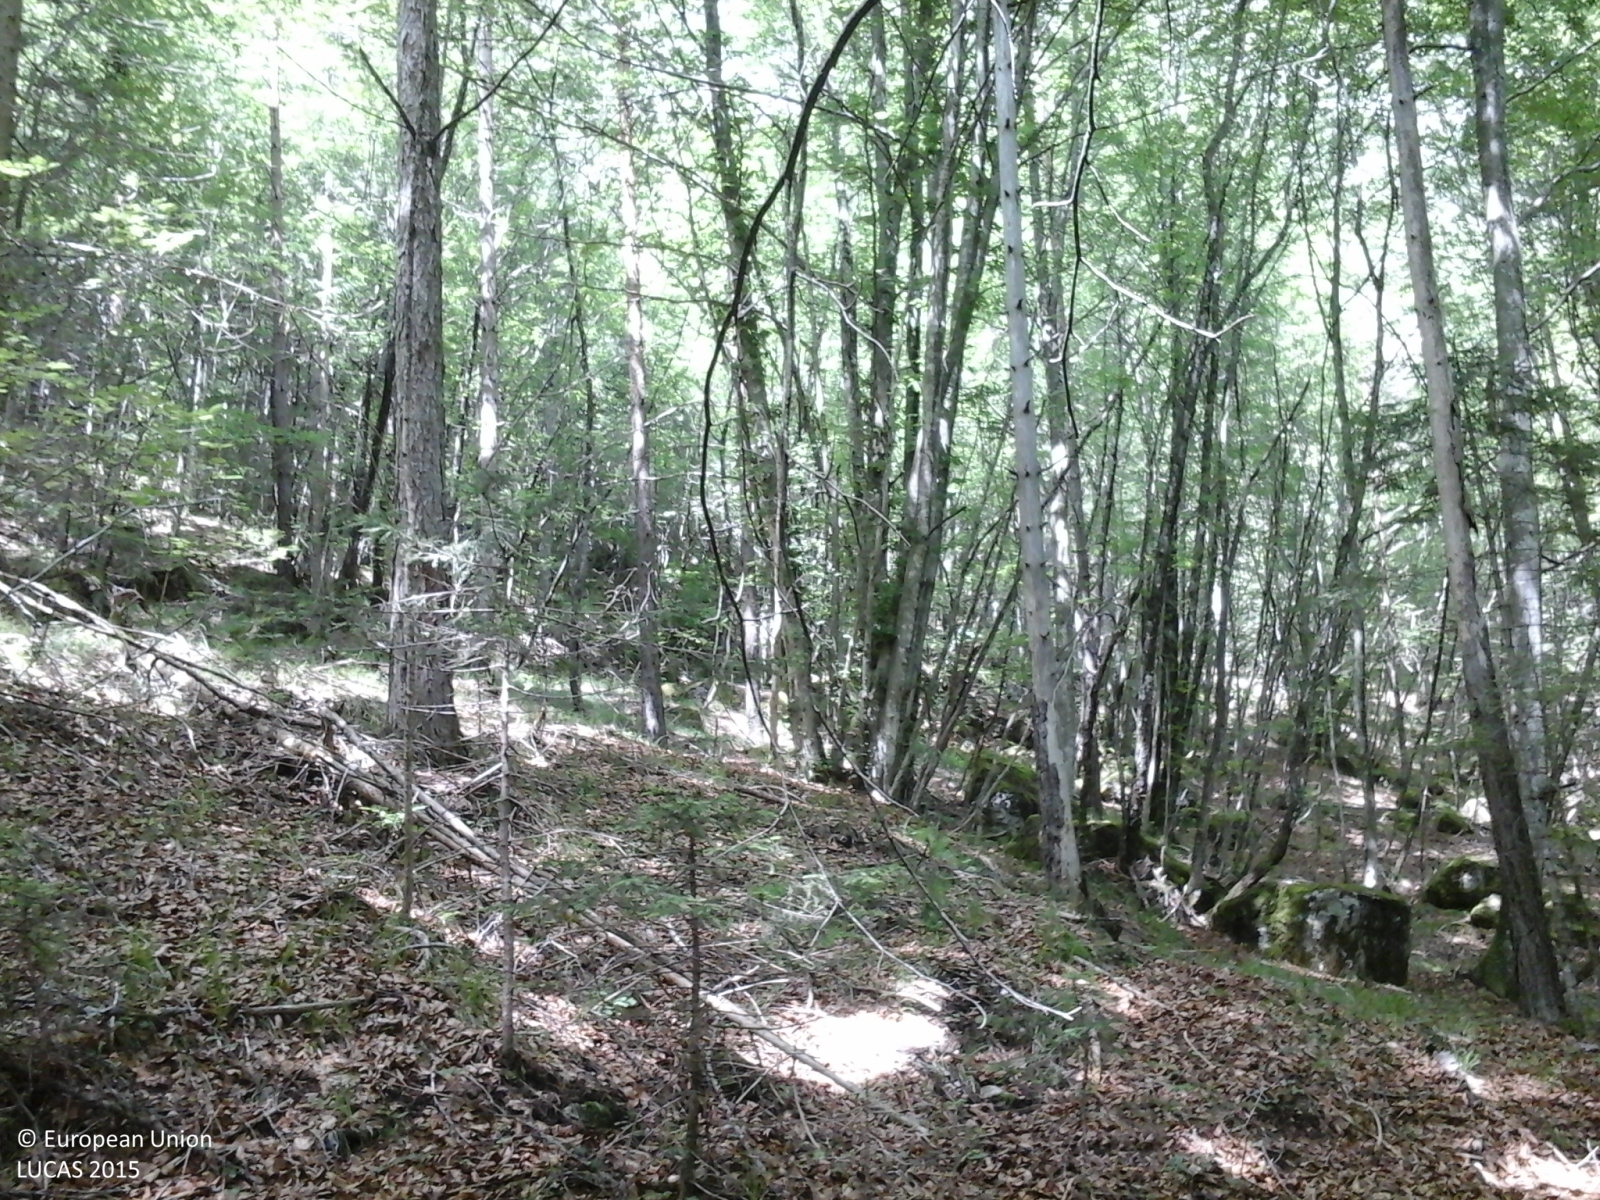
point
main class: Woodland
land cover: Other mixed woodland
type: mountainous beech forest
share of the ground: > 75 %
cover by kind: broadleaved forest trees 70 %, coniferous forest trees 30 %
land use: Semi-natural and natural areas not in use
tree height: > 5 m
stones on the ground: 25 - 50 %
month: June
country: IT
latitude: 46.2973
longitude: 11.9579
